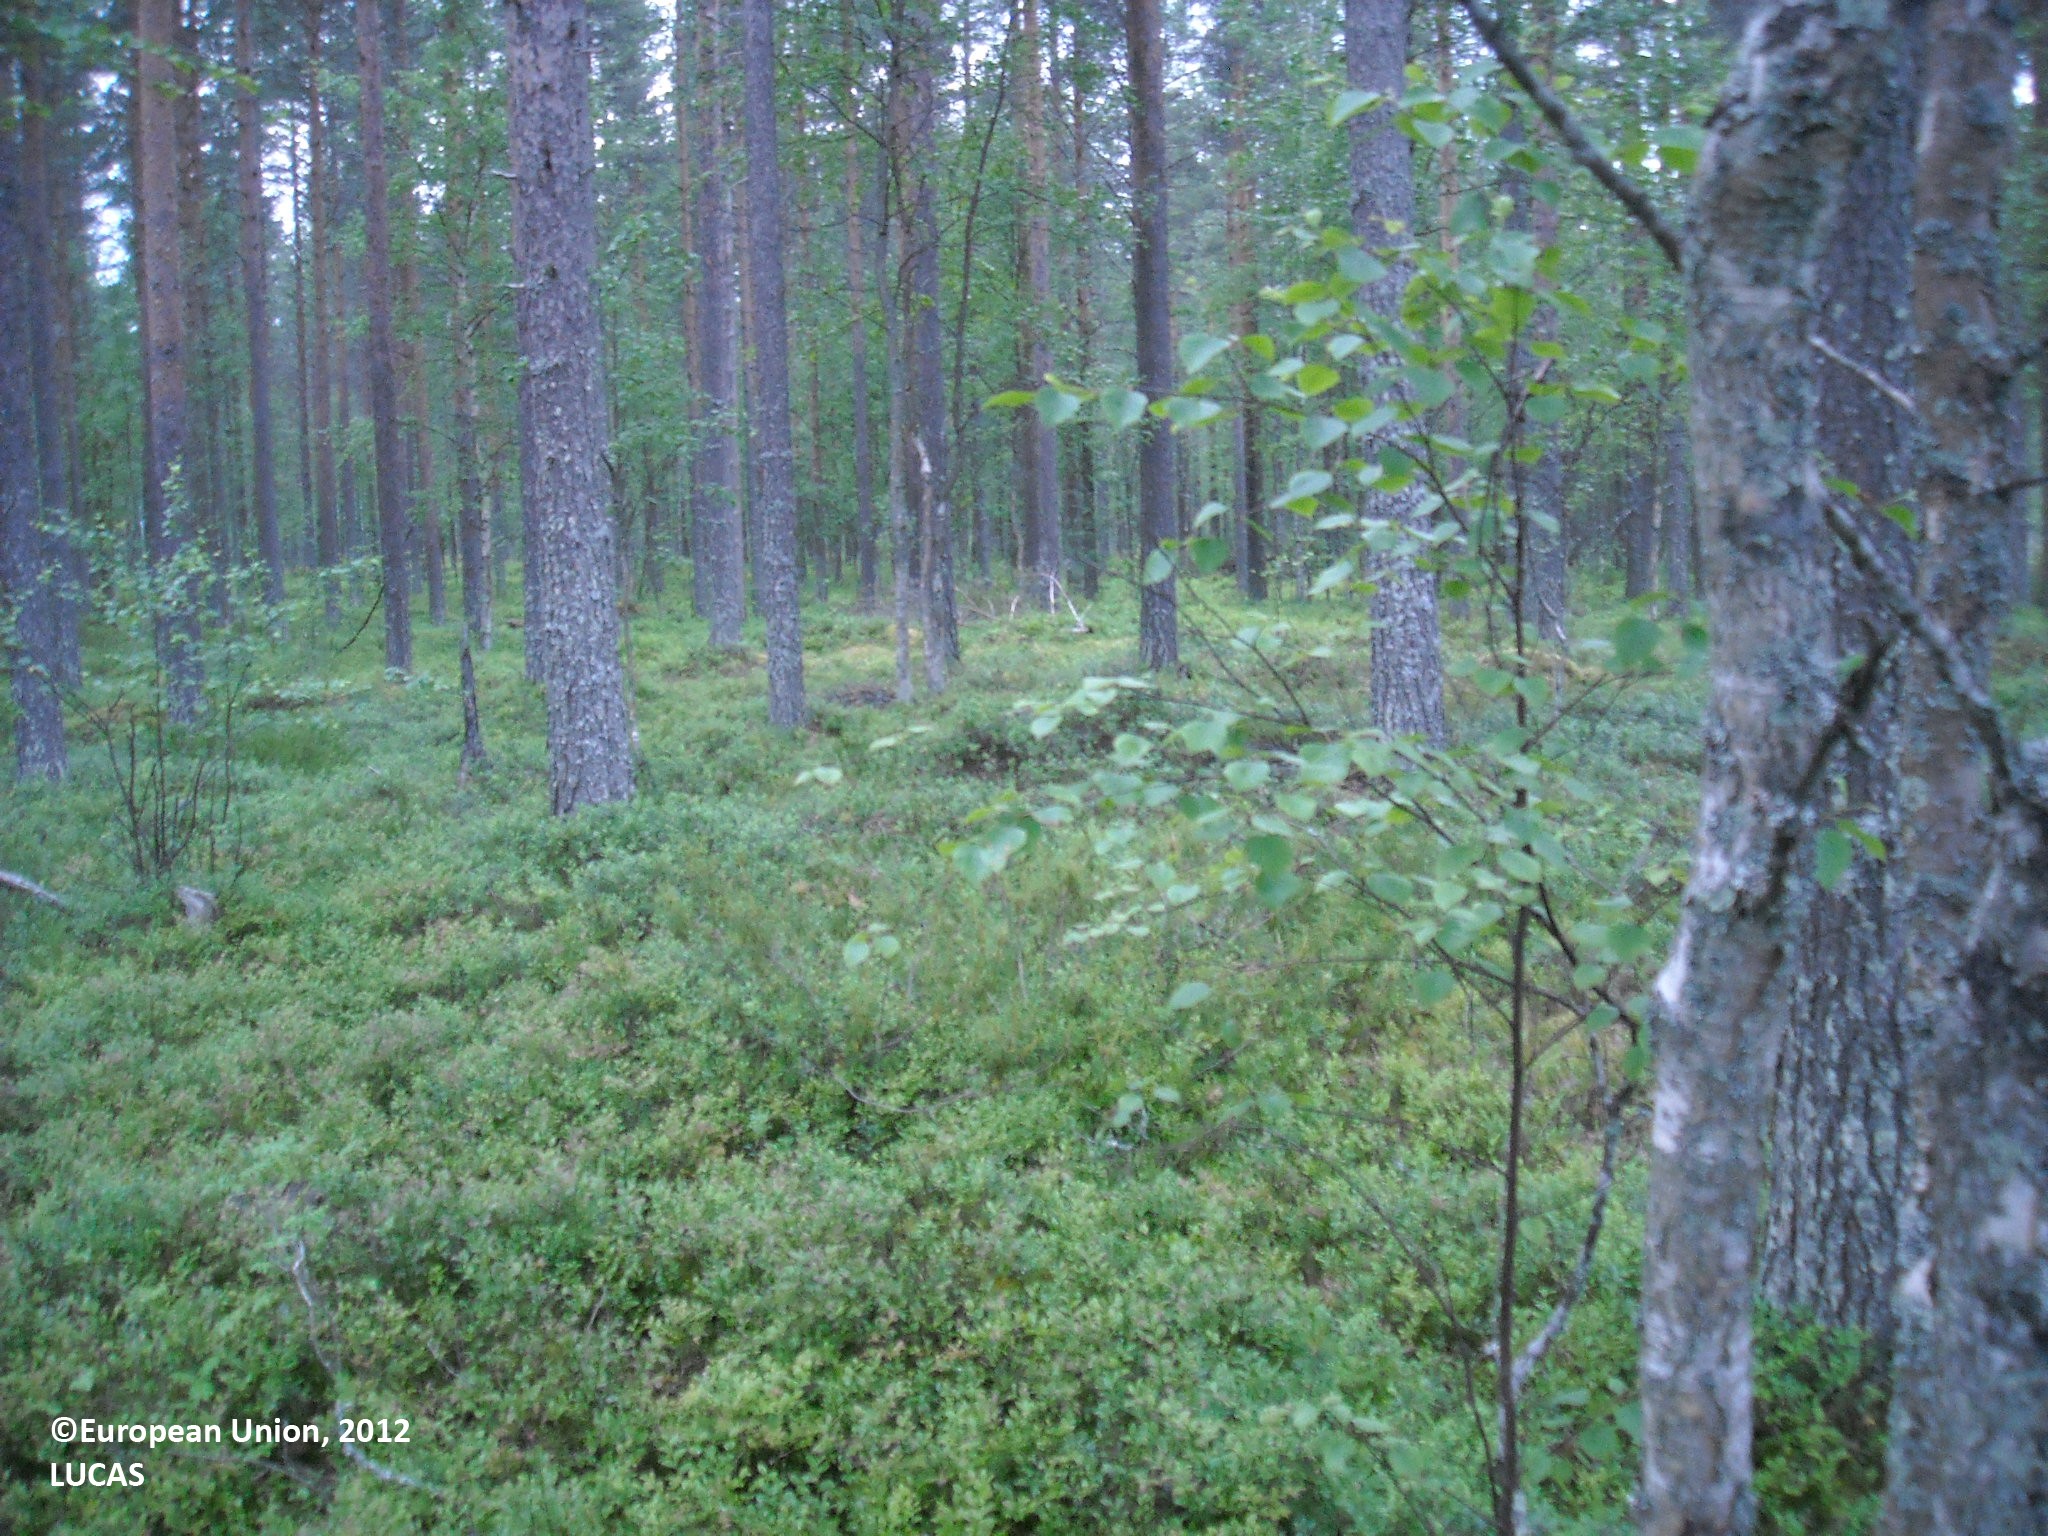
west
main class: Woodland
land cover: Pine dominated coniferous woodland
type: boreal forest
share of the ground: > 75 %
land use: Forestry
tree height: > 5 m
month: July
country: FI
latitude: 65.0440
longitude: 26.7026
